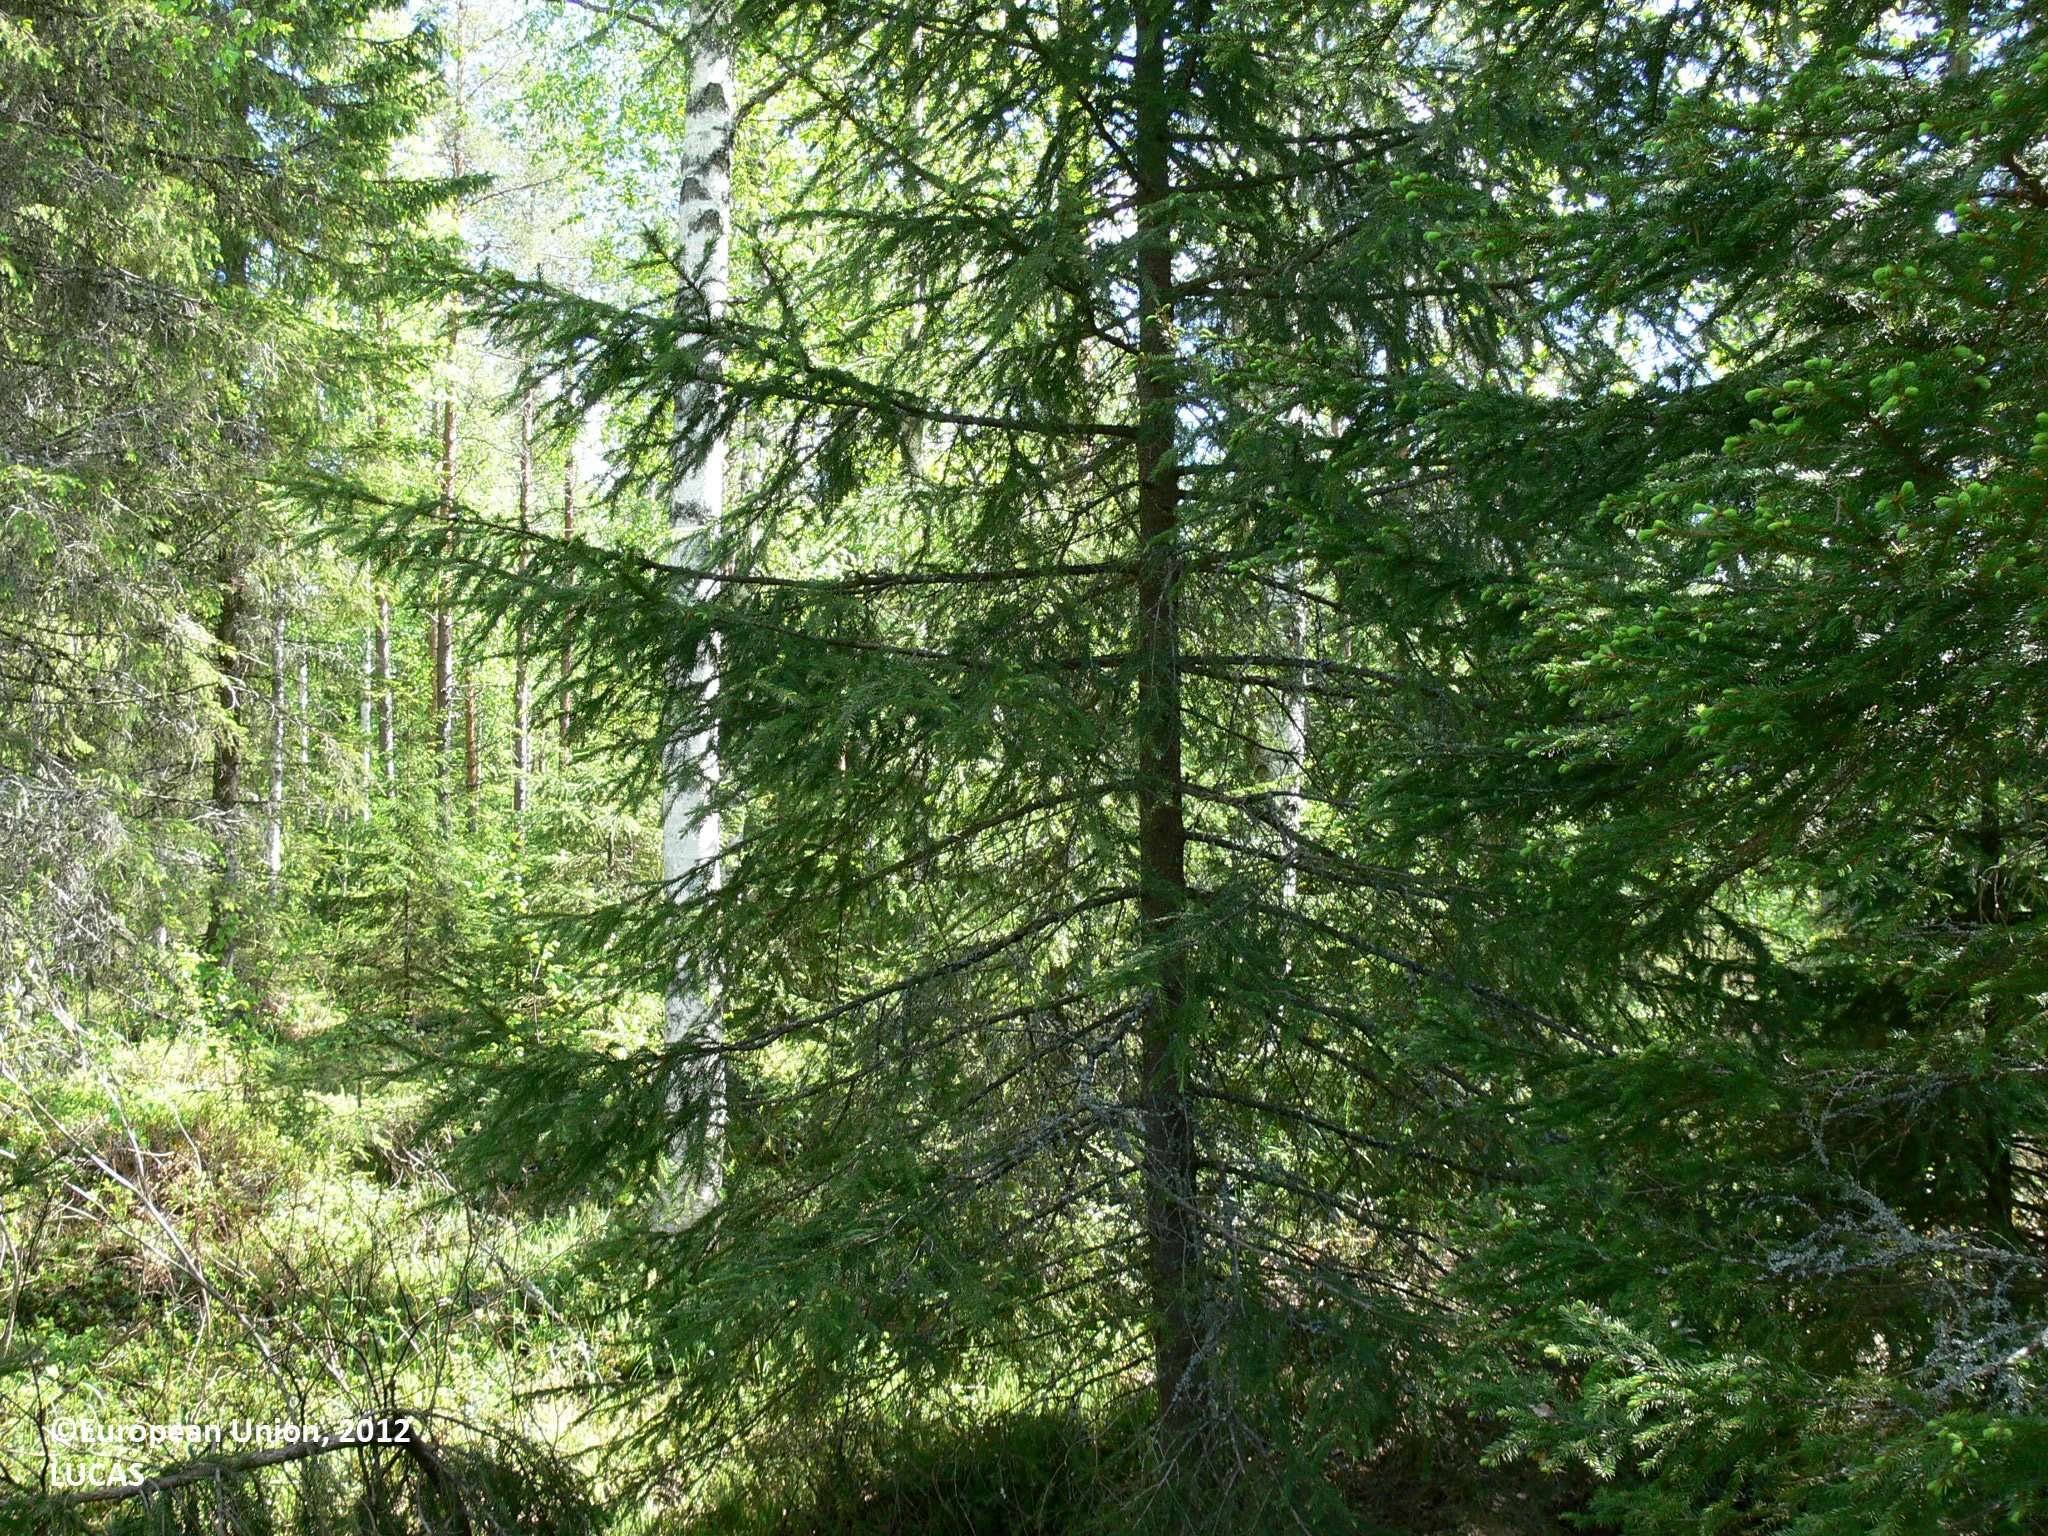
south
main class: Woodland
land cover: Other mixed woodland
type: boreal forest
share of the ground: > 75 %
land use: Forestry
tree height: > 5 m
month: June
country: FI
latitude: 62.5961
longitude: 30.8027
